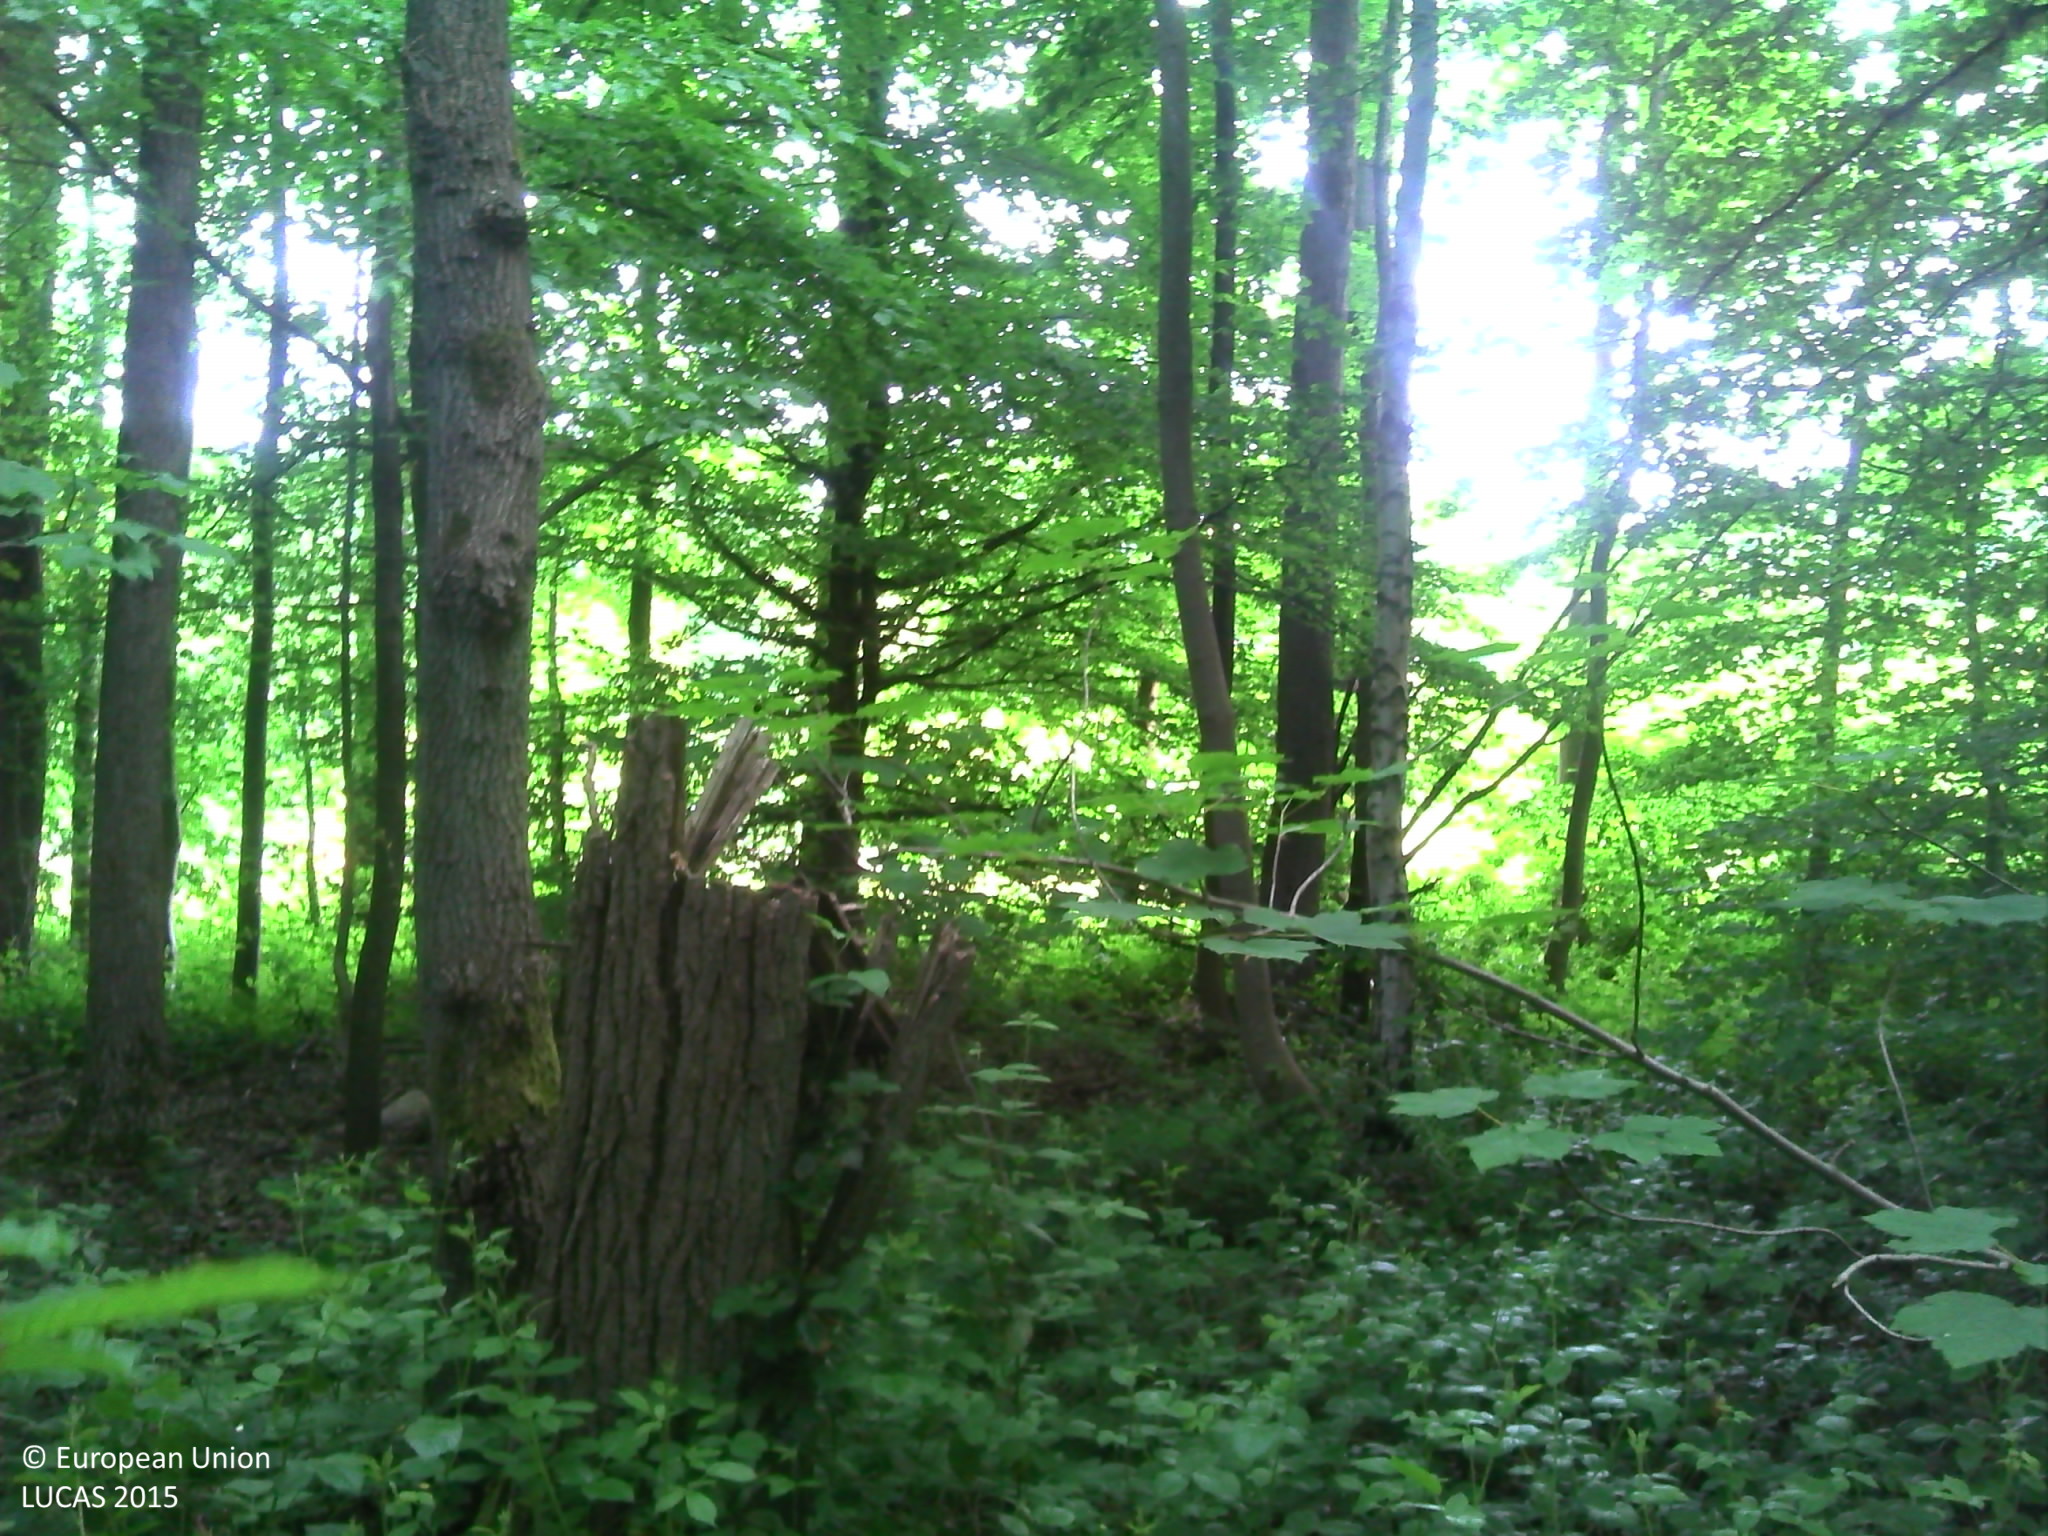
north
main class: Woodland
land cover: Broadleaved woodland
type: mesophytic deciduous forest
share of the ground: > 75 %
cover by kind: broadleaved forest trees 80 %, herbaceous plants 10 %, lichens and mosses 5 %
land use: Forestry
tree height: > 5 m
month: May
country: BE
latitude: 50.3761
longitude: 4.8926
